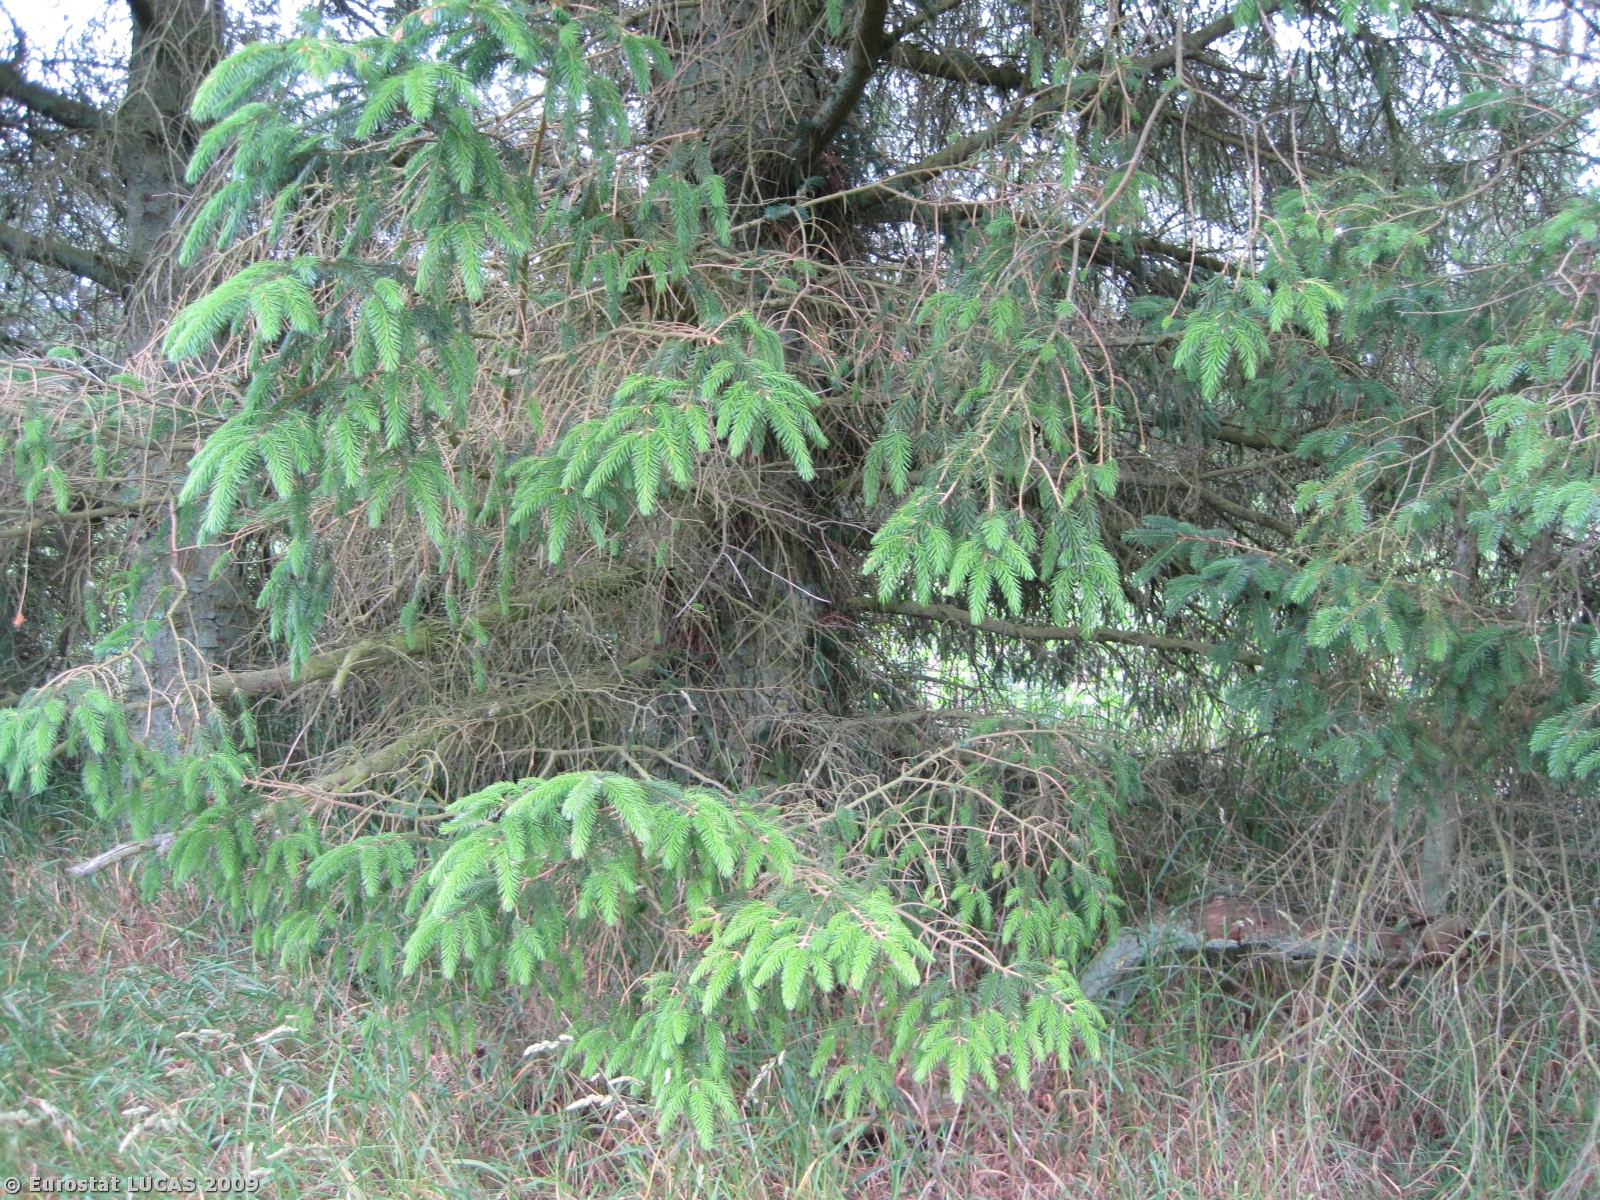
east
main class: Cropland
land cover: Maize
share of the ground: 10 - 25 %
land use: Agriculture (excluding fallow land and kitchen gardens)
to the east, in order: Maize; Grass margins; Coniferous woodland; Grass margins; Maize; Grass margins; Coniferous woodland; Grass margins; Maize; Grass margins; Coniferous woodland; Mixed woodland; Artificial constructions in urban areas; Grassland without tree/shrub cover
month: June
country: DK
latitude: 56.3635
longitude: 8.9815
